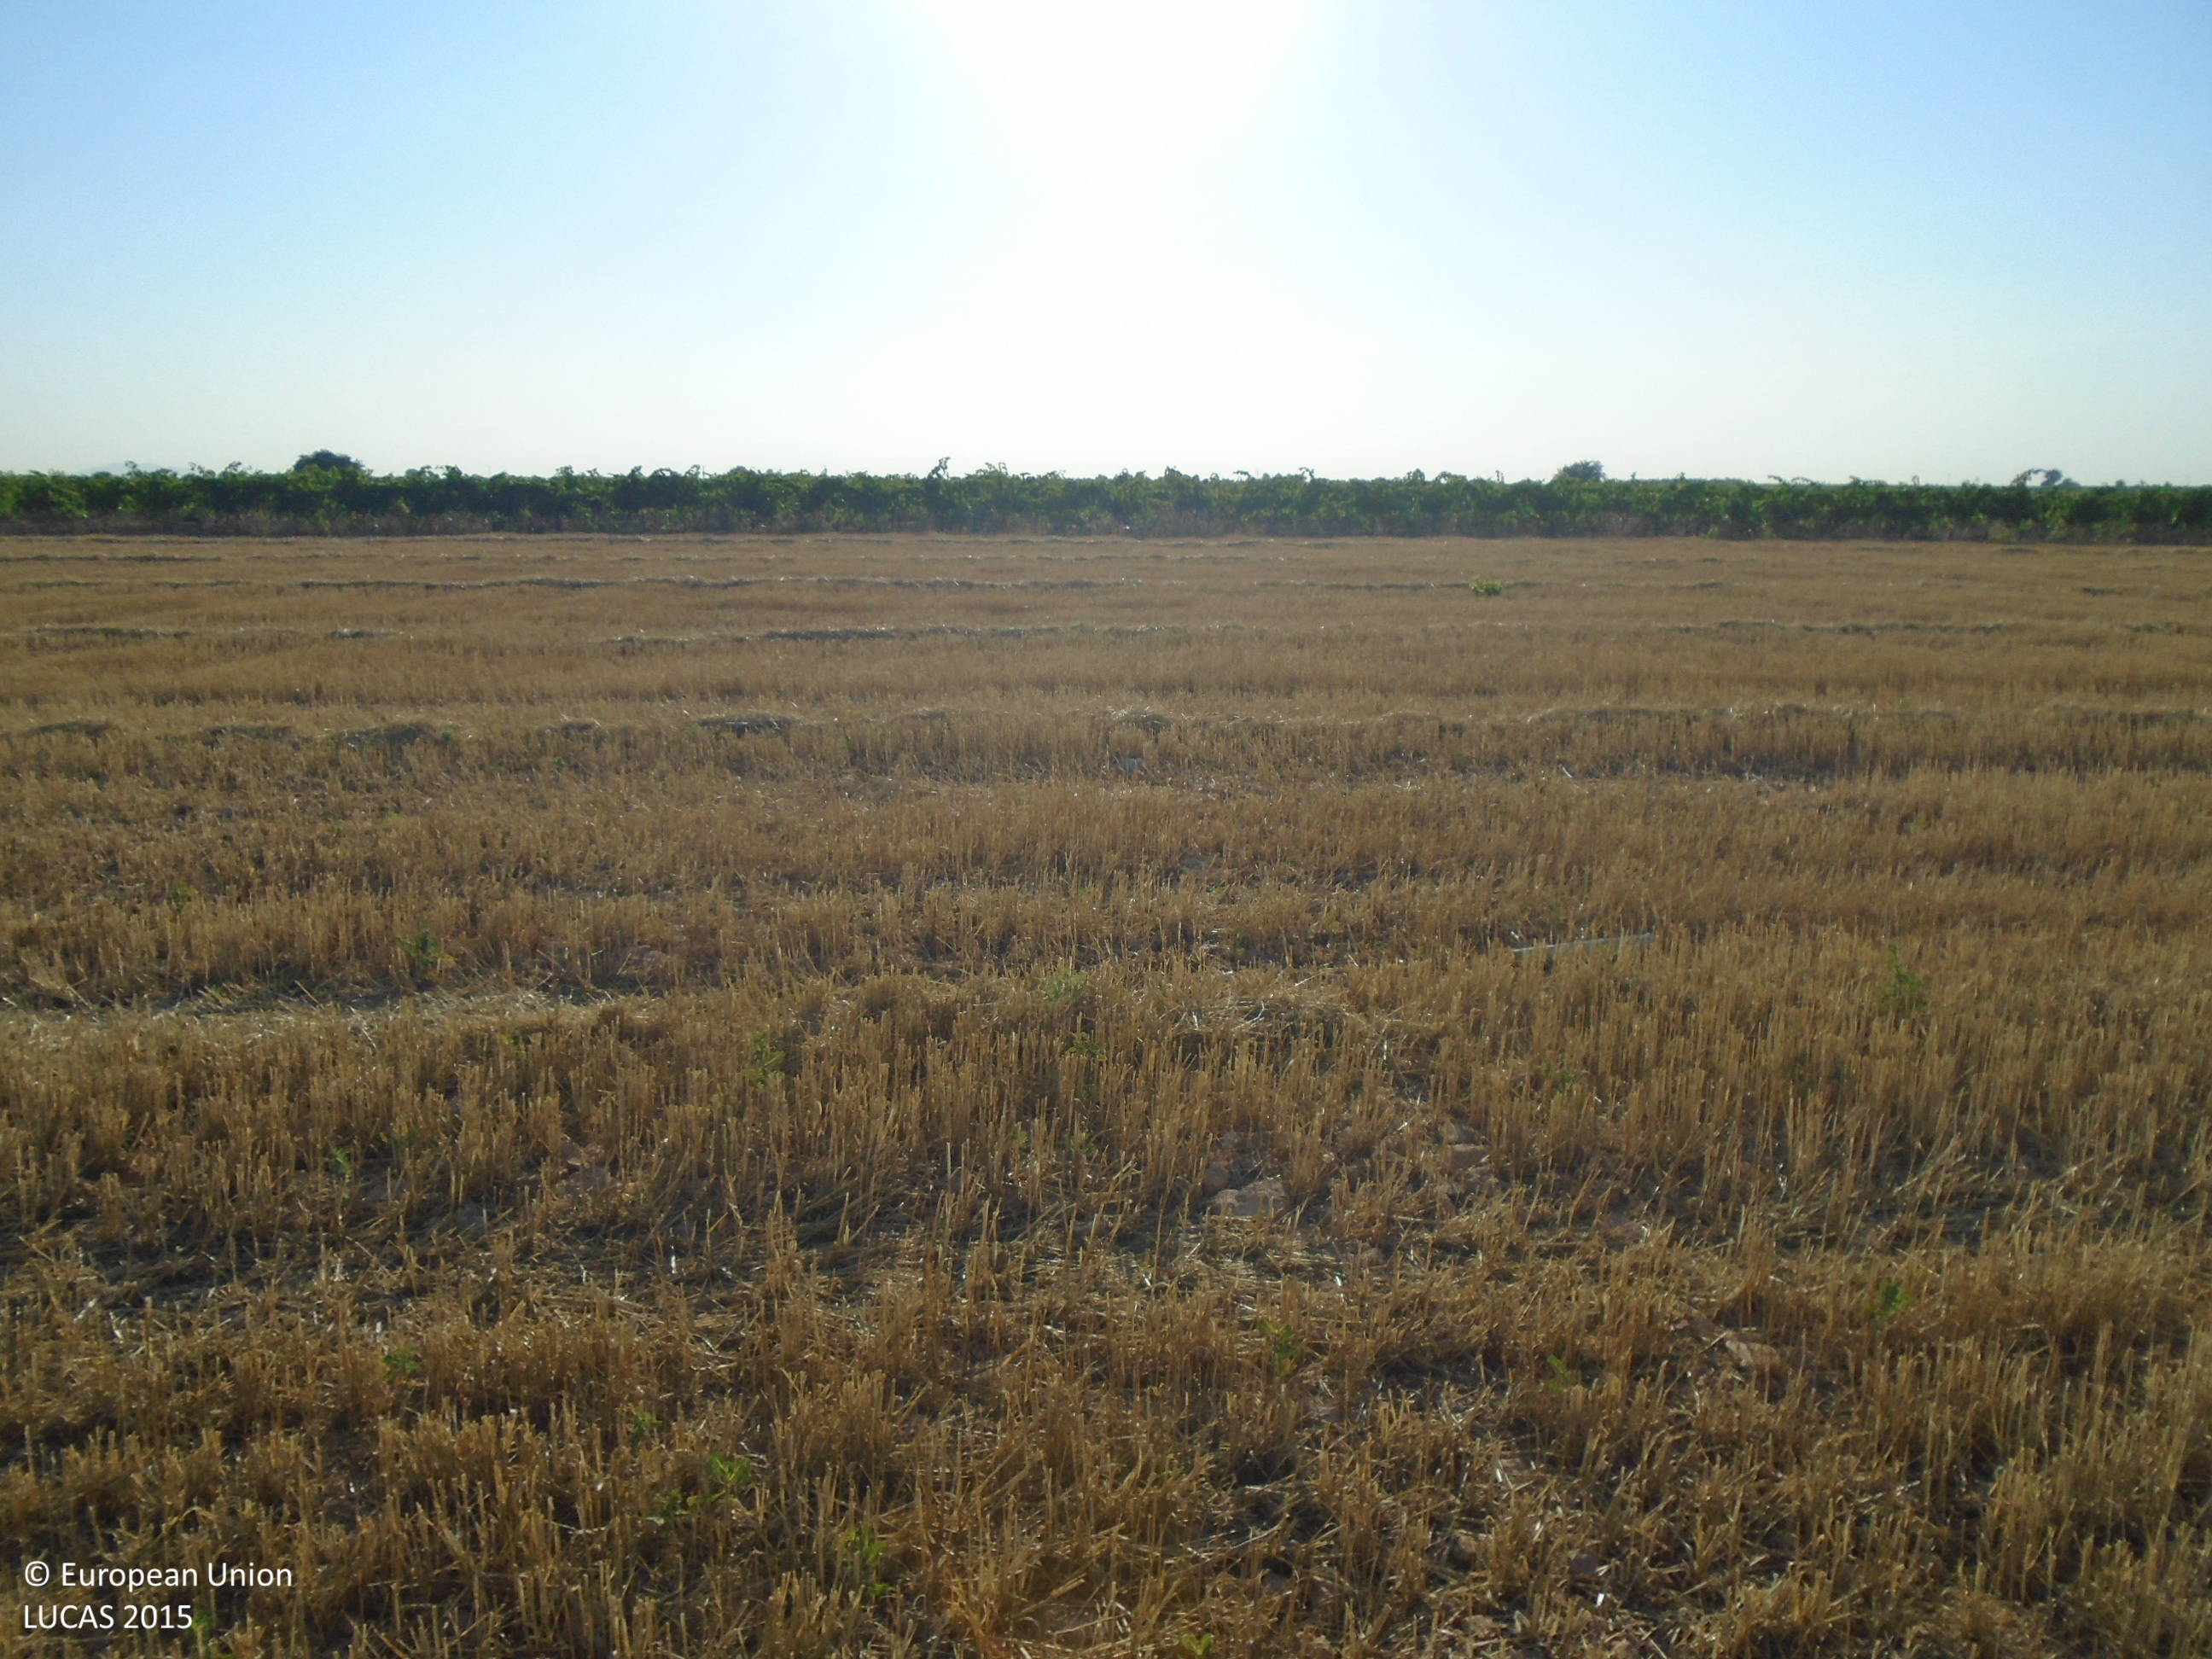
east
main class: Cropland
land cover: Barley
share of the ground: > 75 %
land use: Agriculture (excluding fallow land and kitchen gardens)
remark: Harvested field
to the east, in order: Barley; Tracks; Vineyards; Tracks; Barley
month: June
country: ES
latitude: 39.1694
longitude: -3.5959
